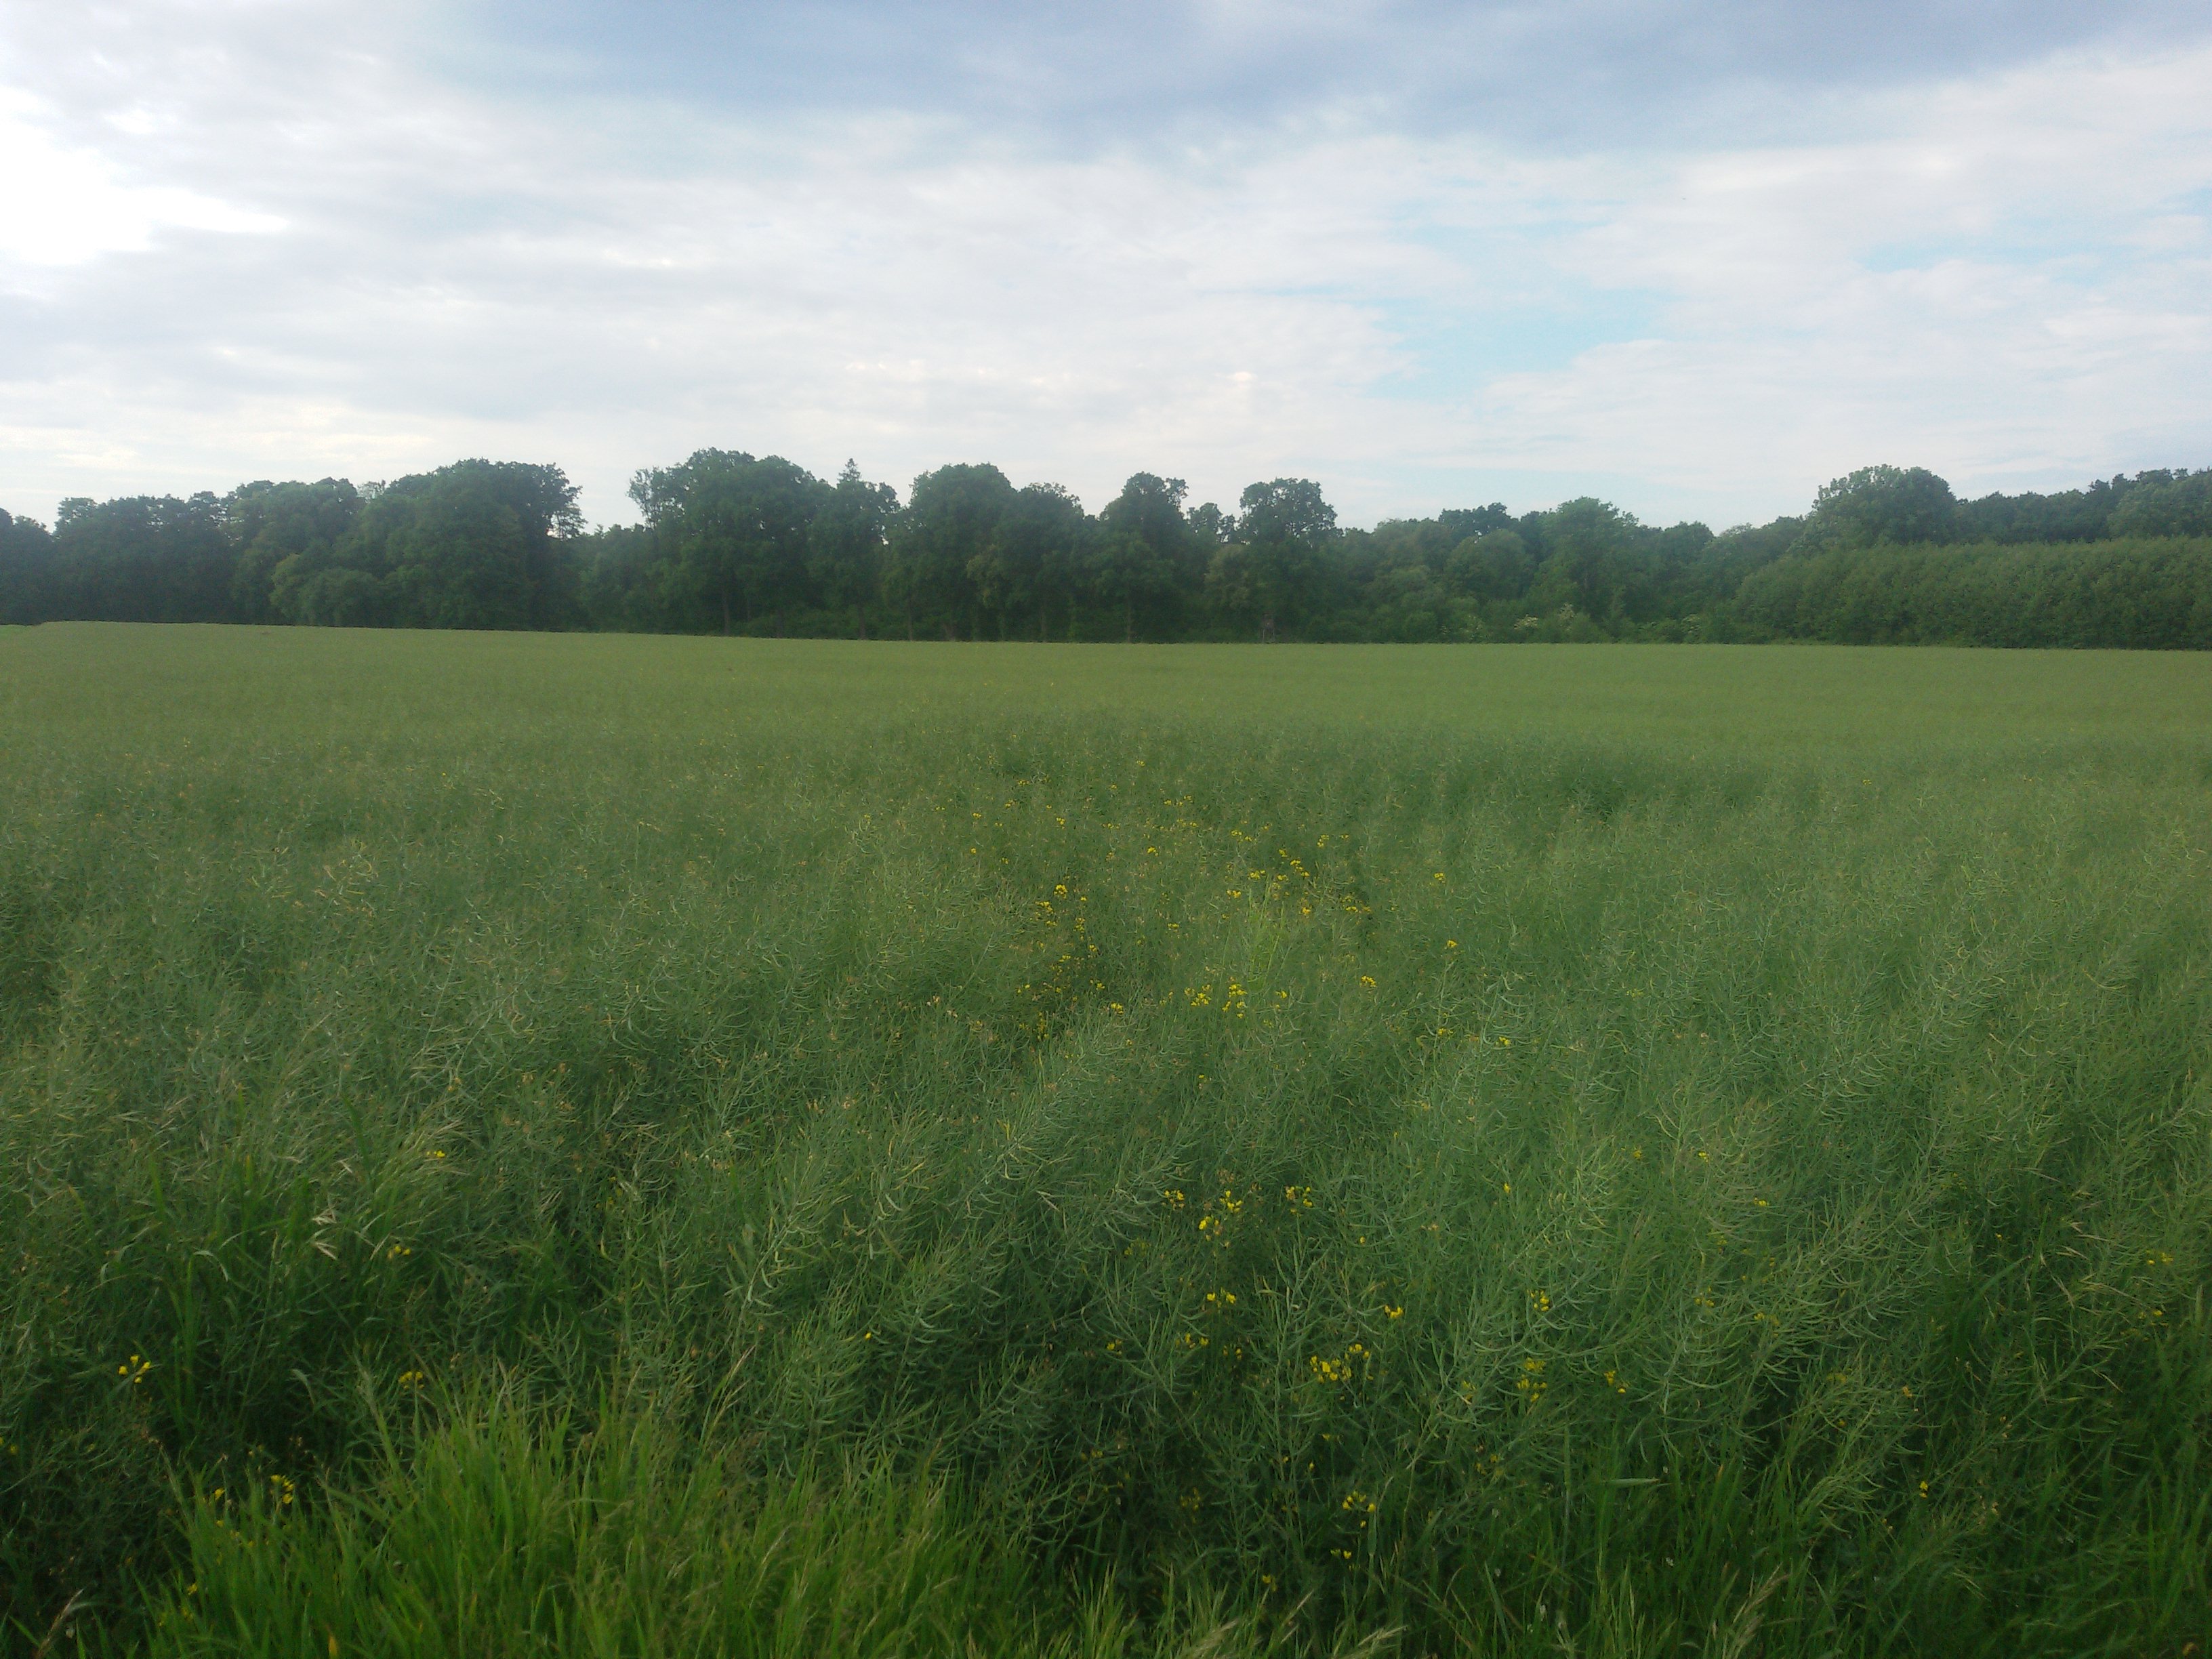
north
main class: Cropland
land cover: Rape and turnip rape
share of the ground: > 75 %
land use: Agriculture (excluding fallow land and kitchen gardens)
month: June
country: PL
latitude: 50.5056
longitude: 17.6416
